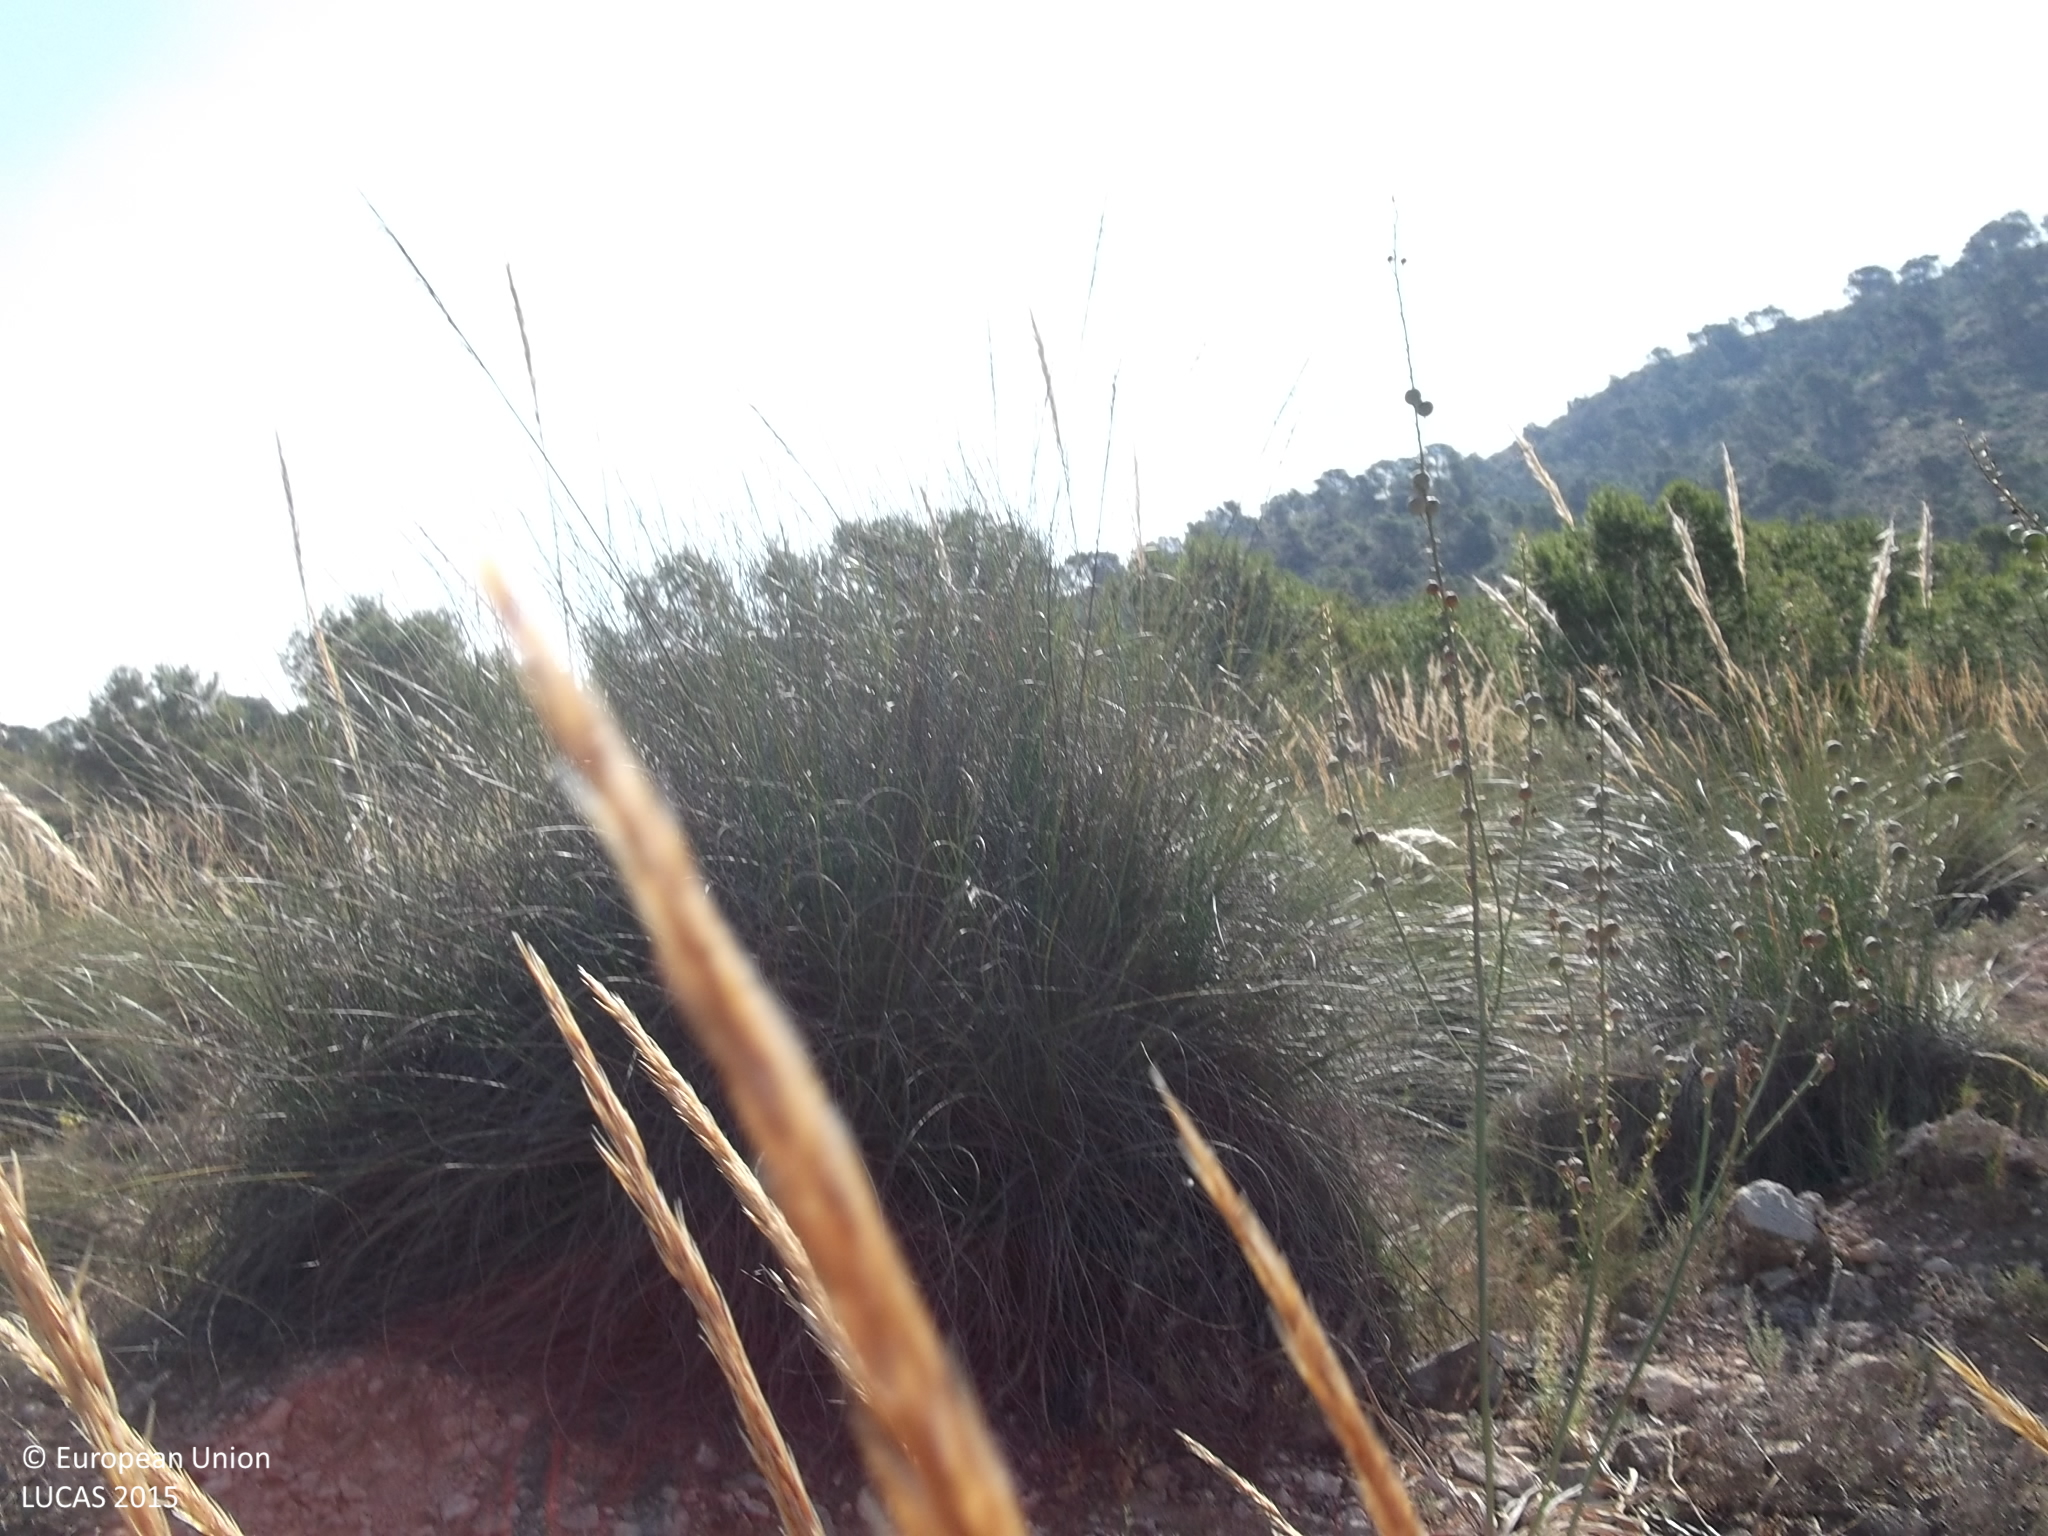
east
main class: Shrubland
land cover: Shrubland without tree cover
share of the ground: 50 - 75 %
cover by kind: shrubs 60 %, herbaceous plants 20 %, consolidated bare surface 20 %
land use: Semi-natural and natural areas not in use
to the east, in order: Shrubland without tree cover; Shrubland with sparse tree cover; Pine dominated coniferous woodland
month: May
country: ES
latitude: 38.4371
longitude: -1.5050
